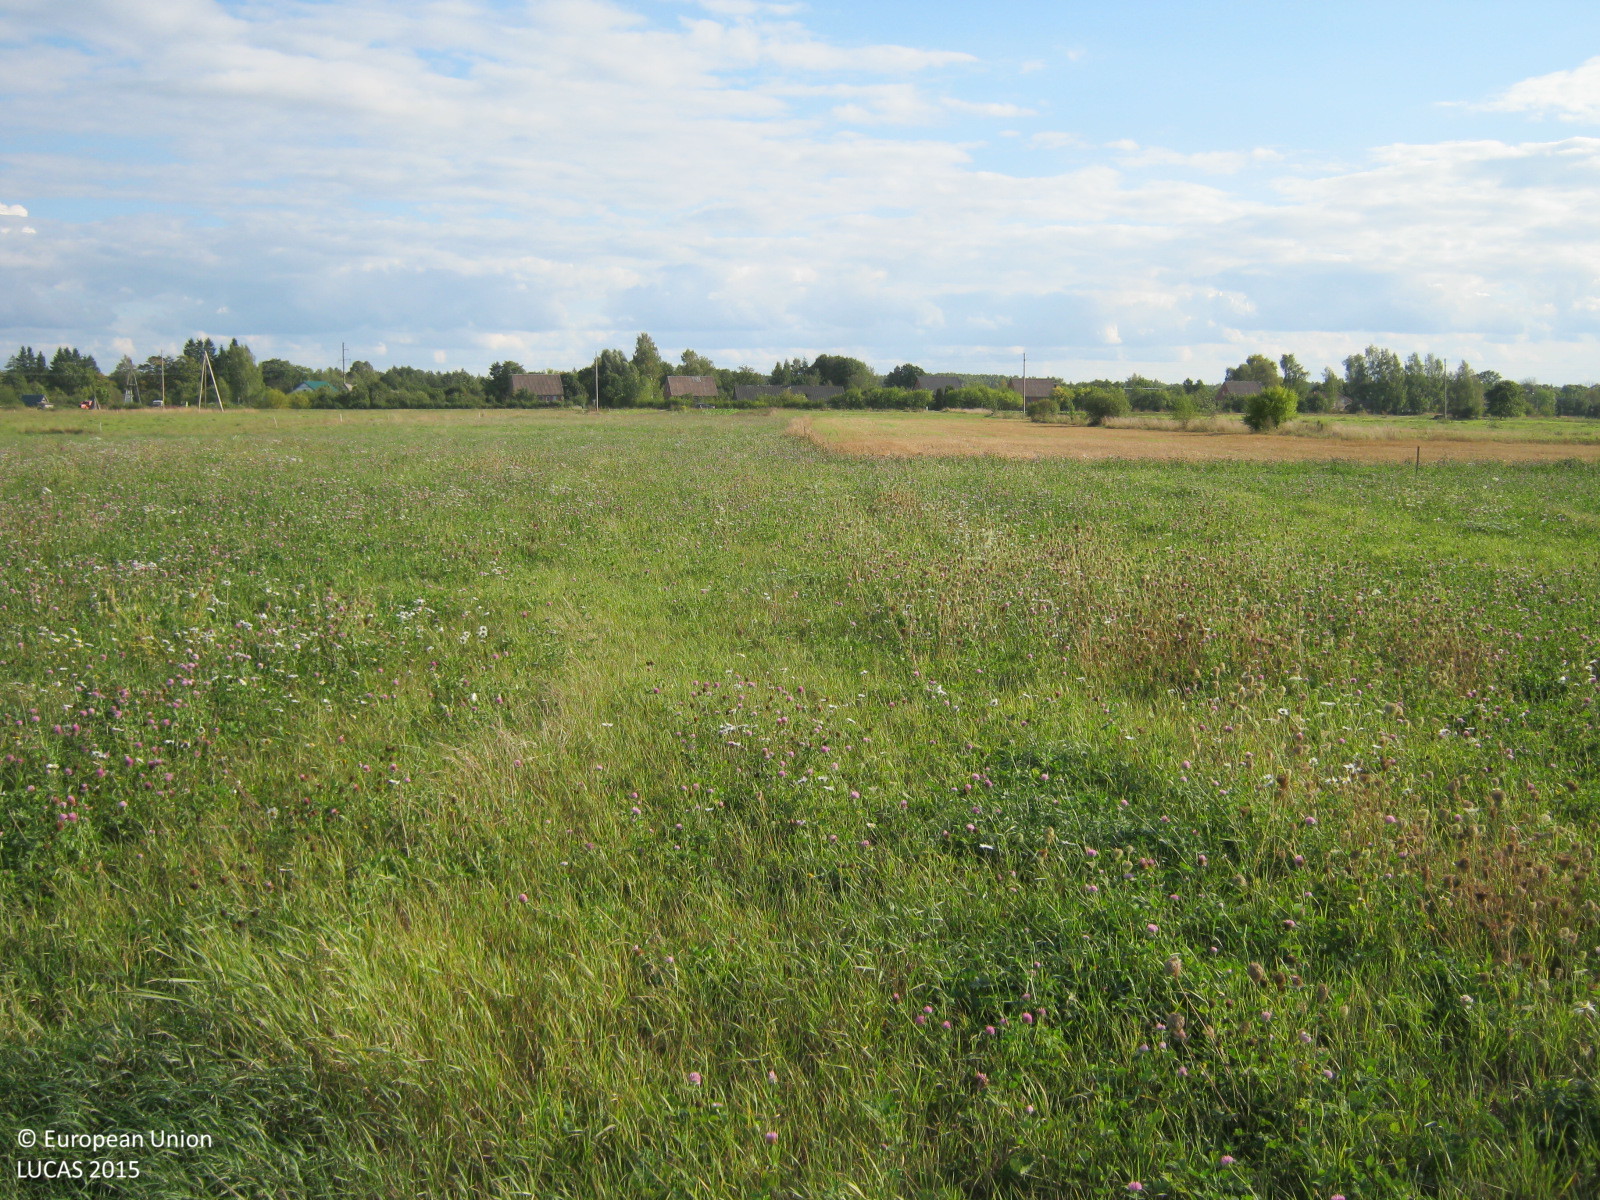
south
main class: Cropland
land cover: Clovers
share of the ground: > 75 %
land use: Agriculture (excluding fallow land and kitchen gardens)
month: September
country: LV
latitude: 57.3360
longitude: 24.4951
